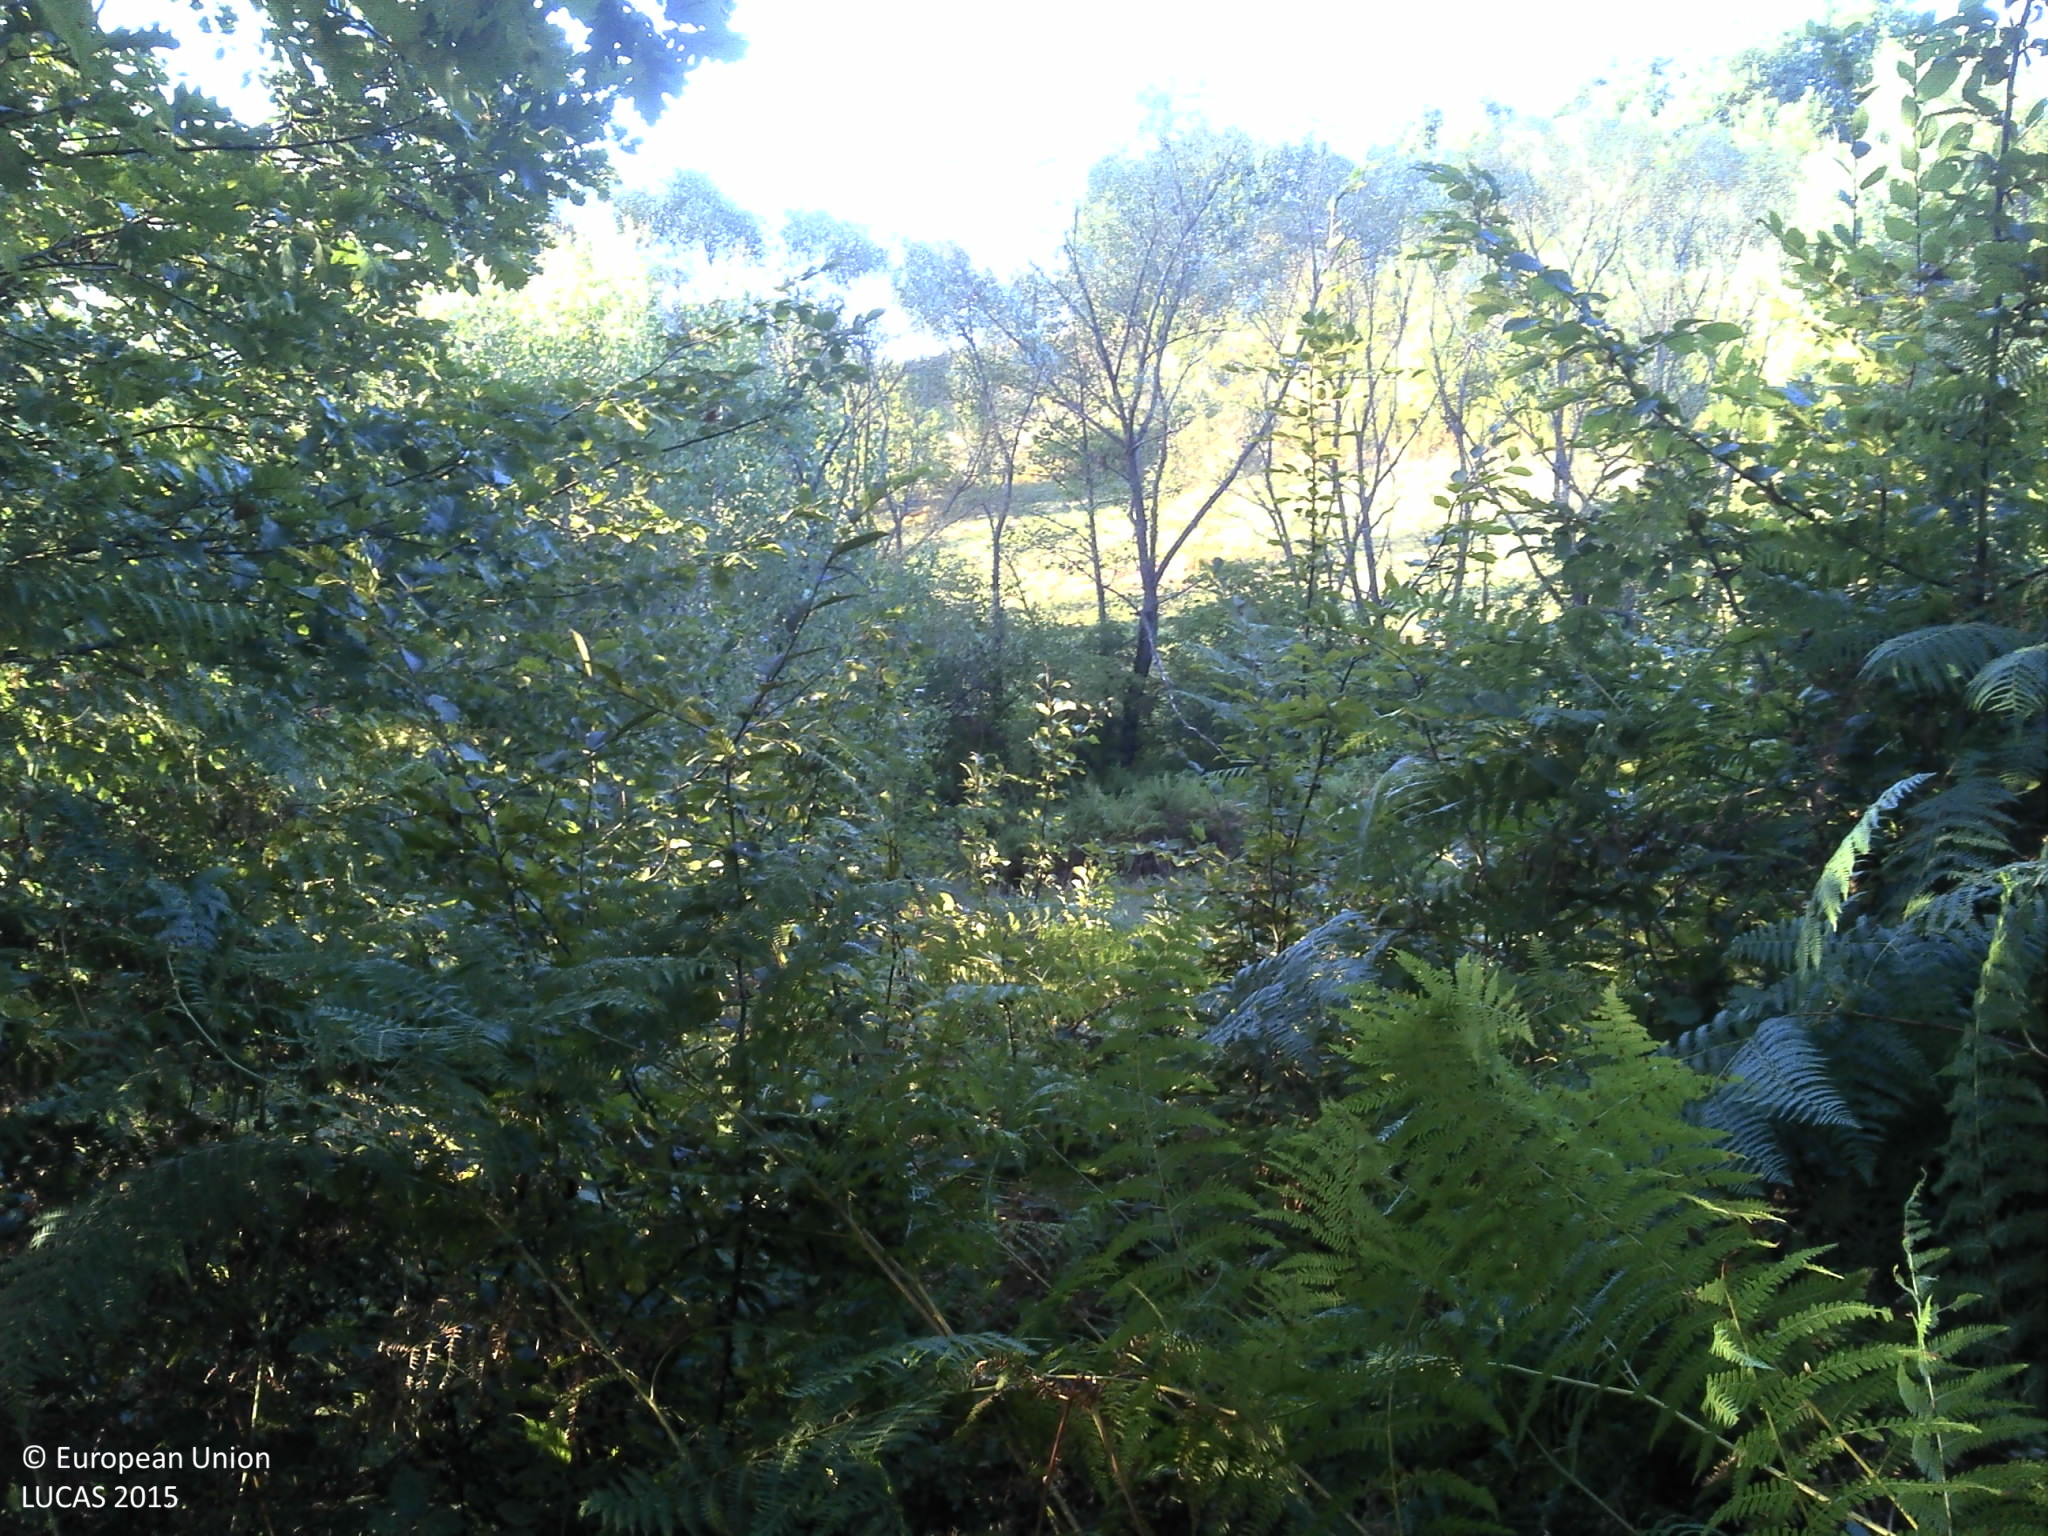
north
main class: Shrubland
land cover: Shrubland with sparse tree cover
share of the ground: > 75 %
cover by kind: shrubs 90 %, broadleaved forest trees 5 %, herbaceous plants 5 %
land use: Semi-natural and natural areas not in use
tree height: < 5 m
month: August
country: HR
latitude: 45.2976
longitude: 16.3093
